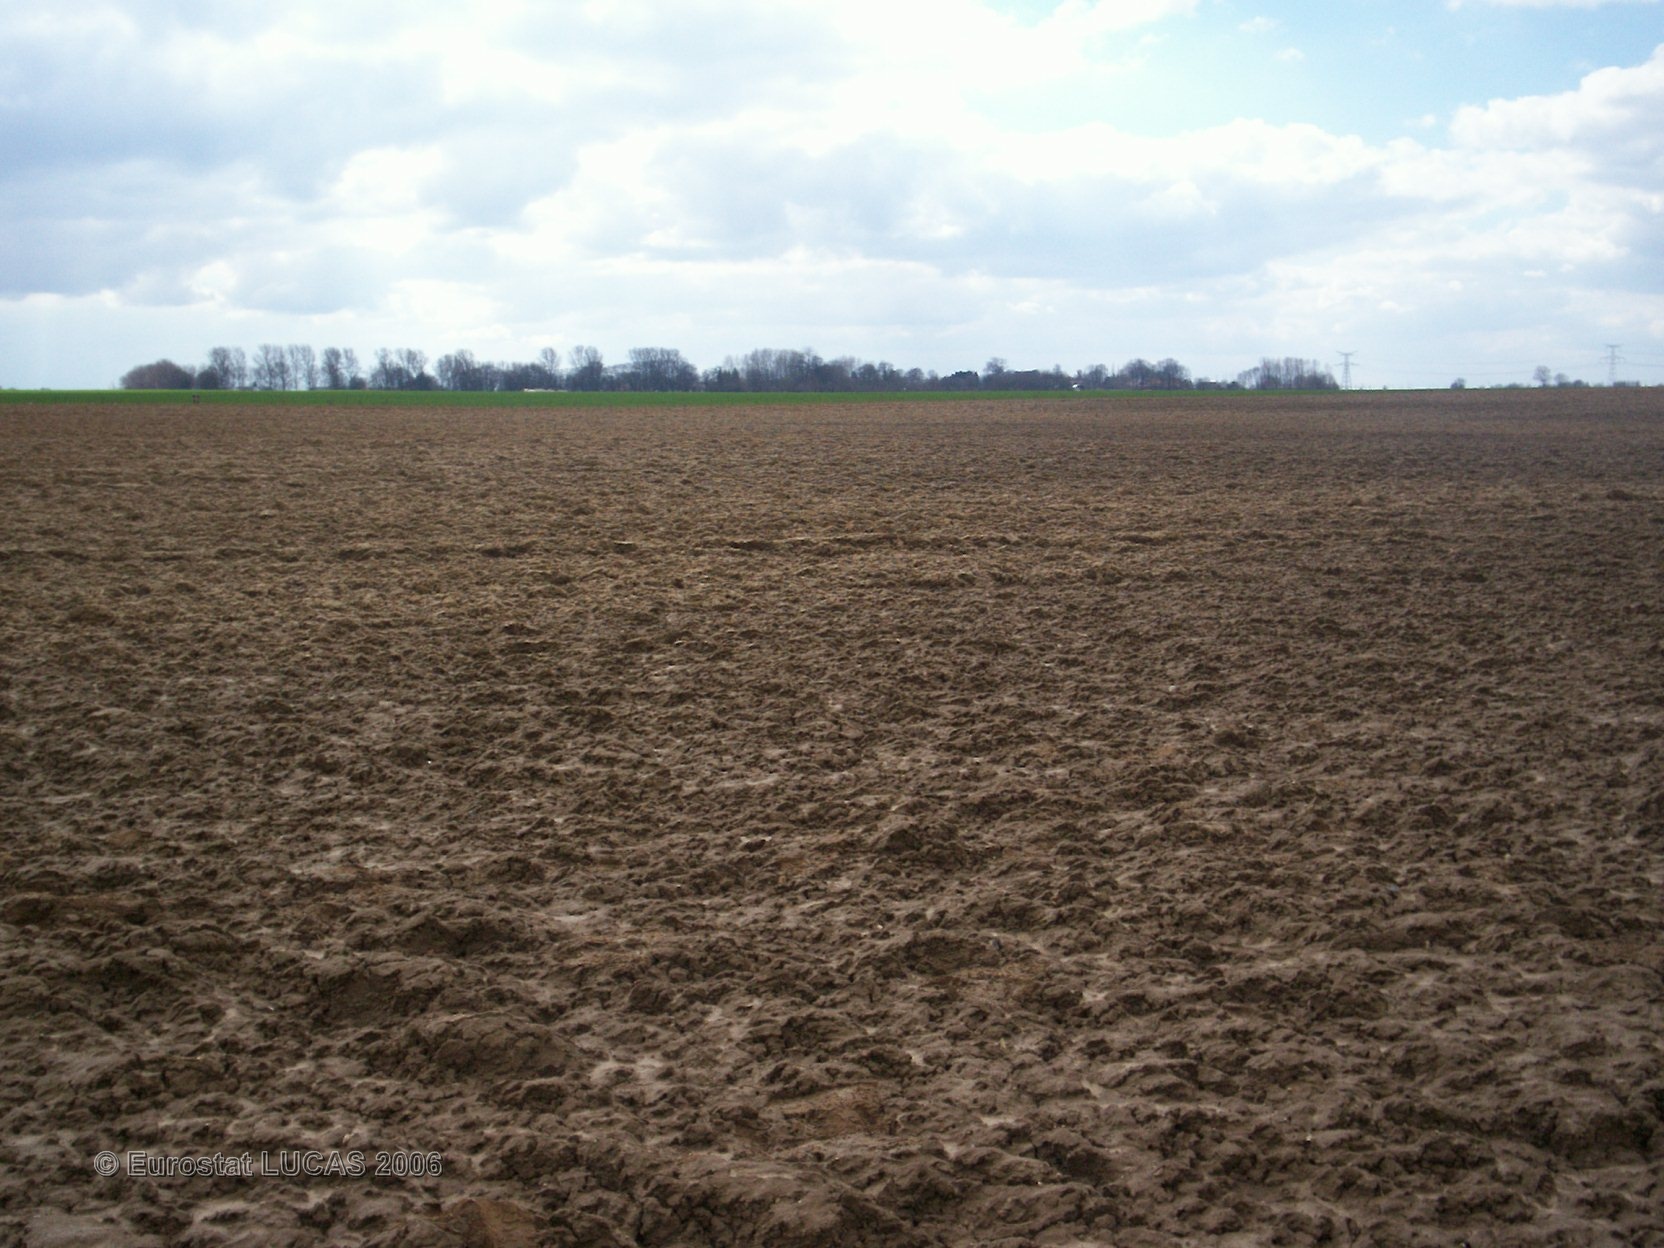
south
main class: Cropland
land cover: Maize
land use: Agriculture (excluding fallow land and kitchen gardens)
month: June
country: FR
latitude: 50.1001
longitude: 2.5081
